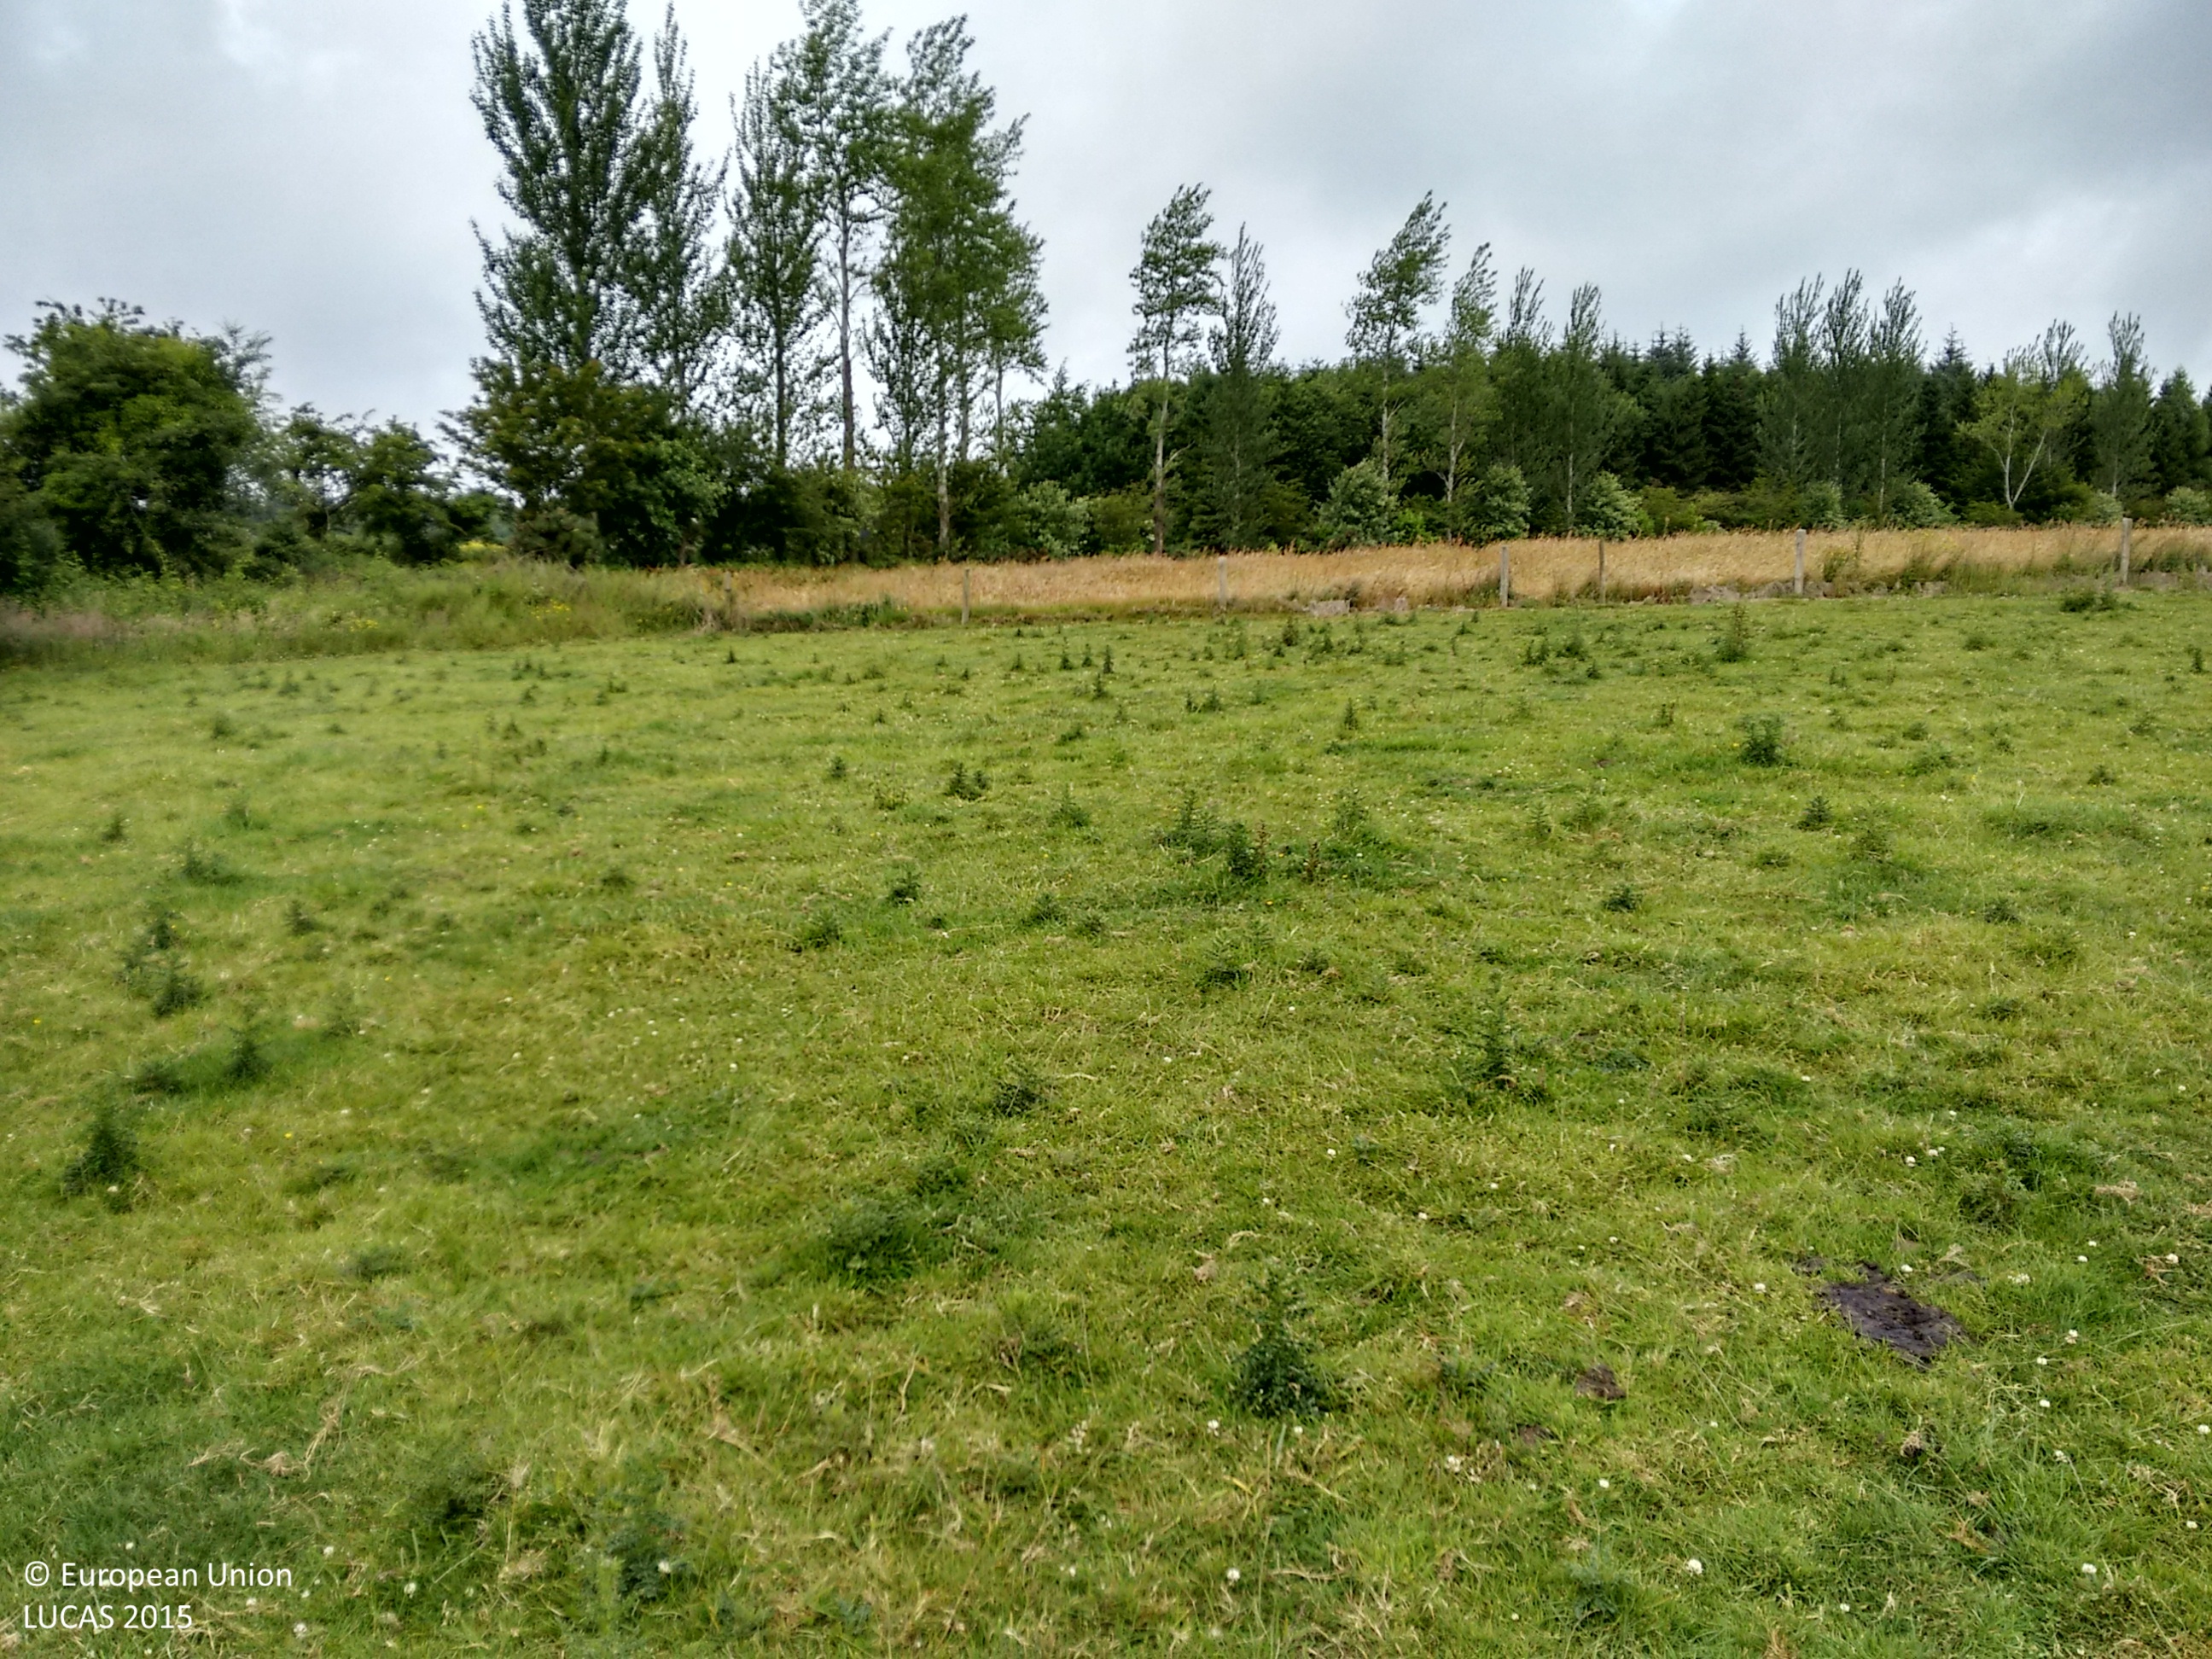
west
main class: Grassland
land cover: Grassland without tree/shrub cover
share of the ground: > 75 %
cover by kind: herbaceous plants 100 %
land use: Agriculture (excluding fallow land and kitchen gardens)
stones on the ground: < 10 %
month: June
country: IE
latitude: 52.3042
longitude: -7.3269
